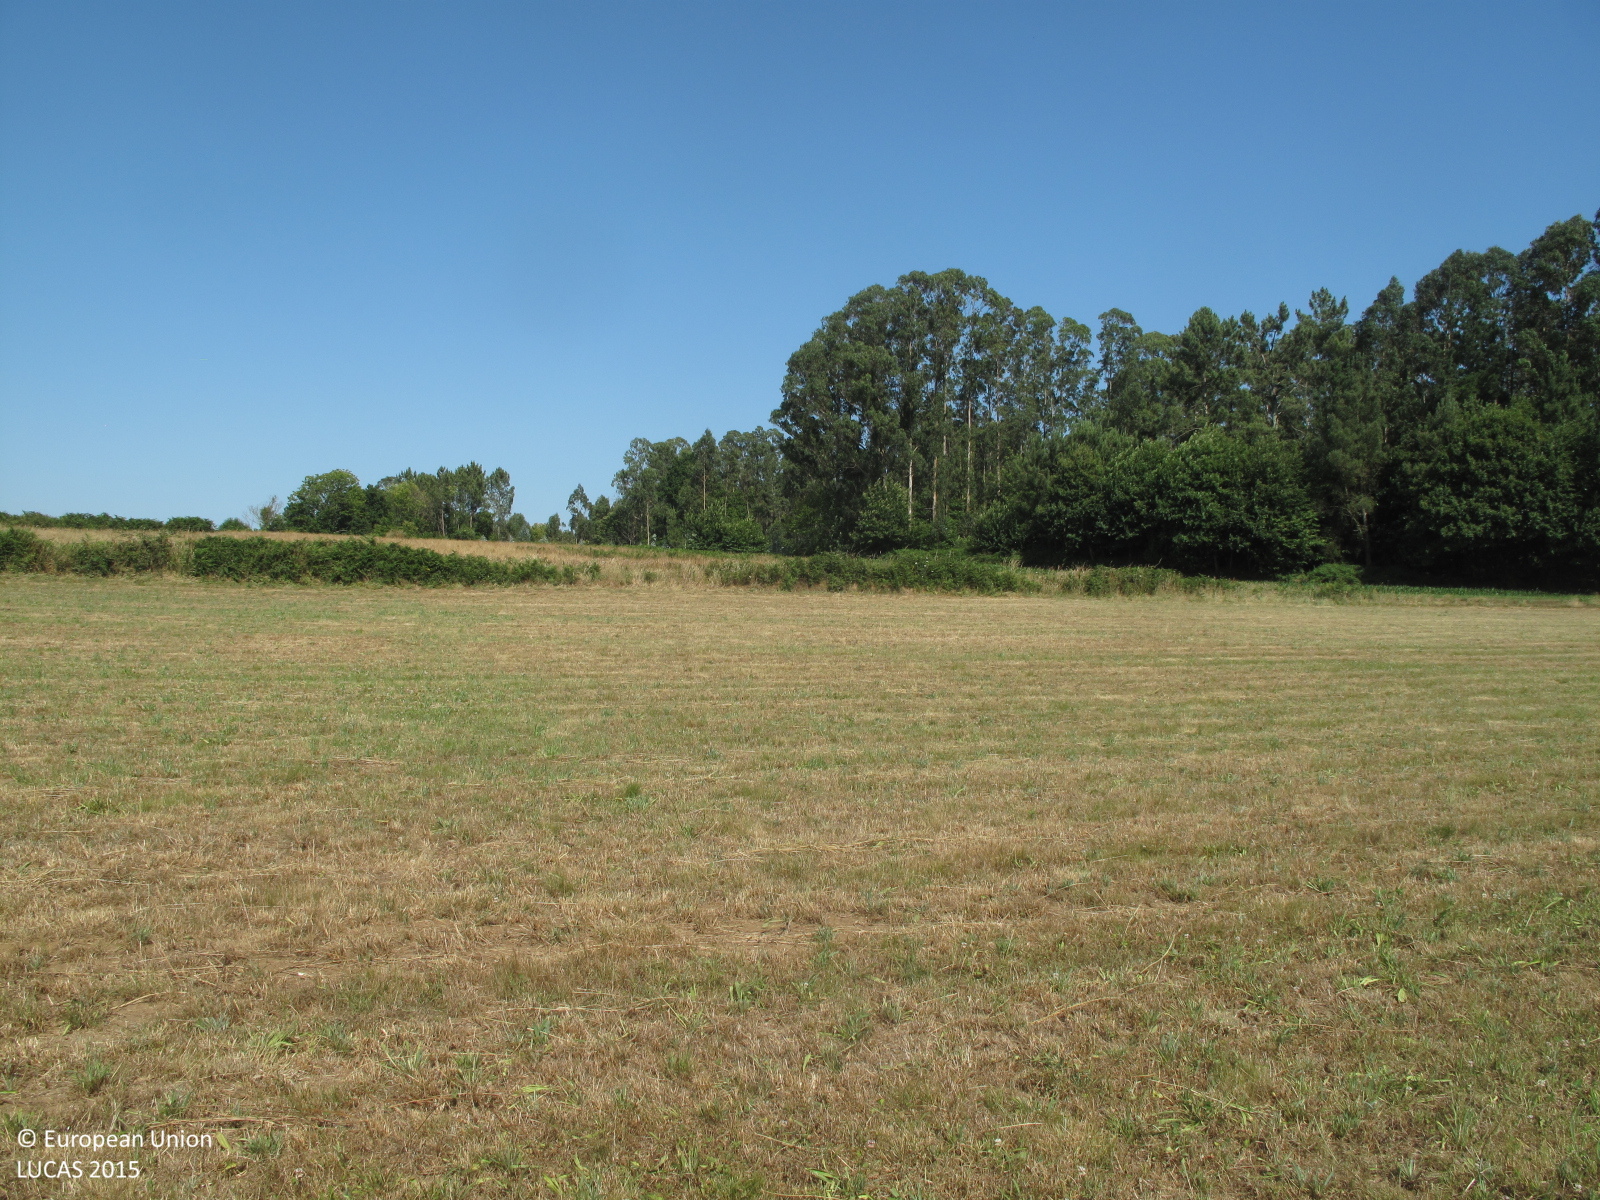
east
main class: Shrubland
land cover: Shrubland with sparse tree cover
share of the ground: 10 - 25 %
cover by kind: herbaceous plants 75 %, shrubs 20 %, broadleaved forest trees 5 %
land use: Abandoned areas
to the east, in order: Shrubland with sparse tree cover; Grassland without tree/shrub cover; Shruby margins; Grassland without tree/shrub cover; Maize; Pine dominated mixed woodland; Electric lines; Pine dominated mixed woodland; Paved roads, cycling and walking lanes
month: July
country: ES
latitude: 43.3431
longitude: -8.1455
